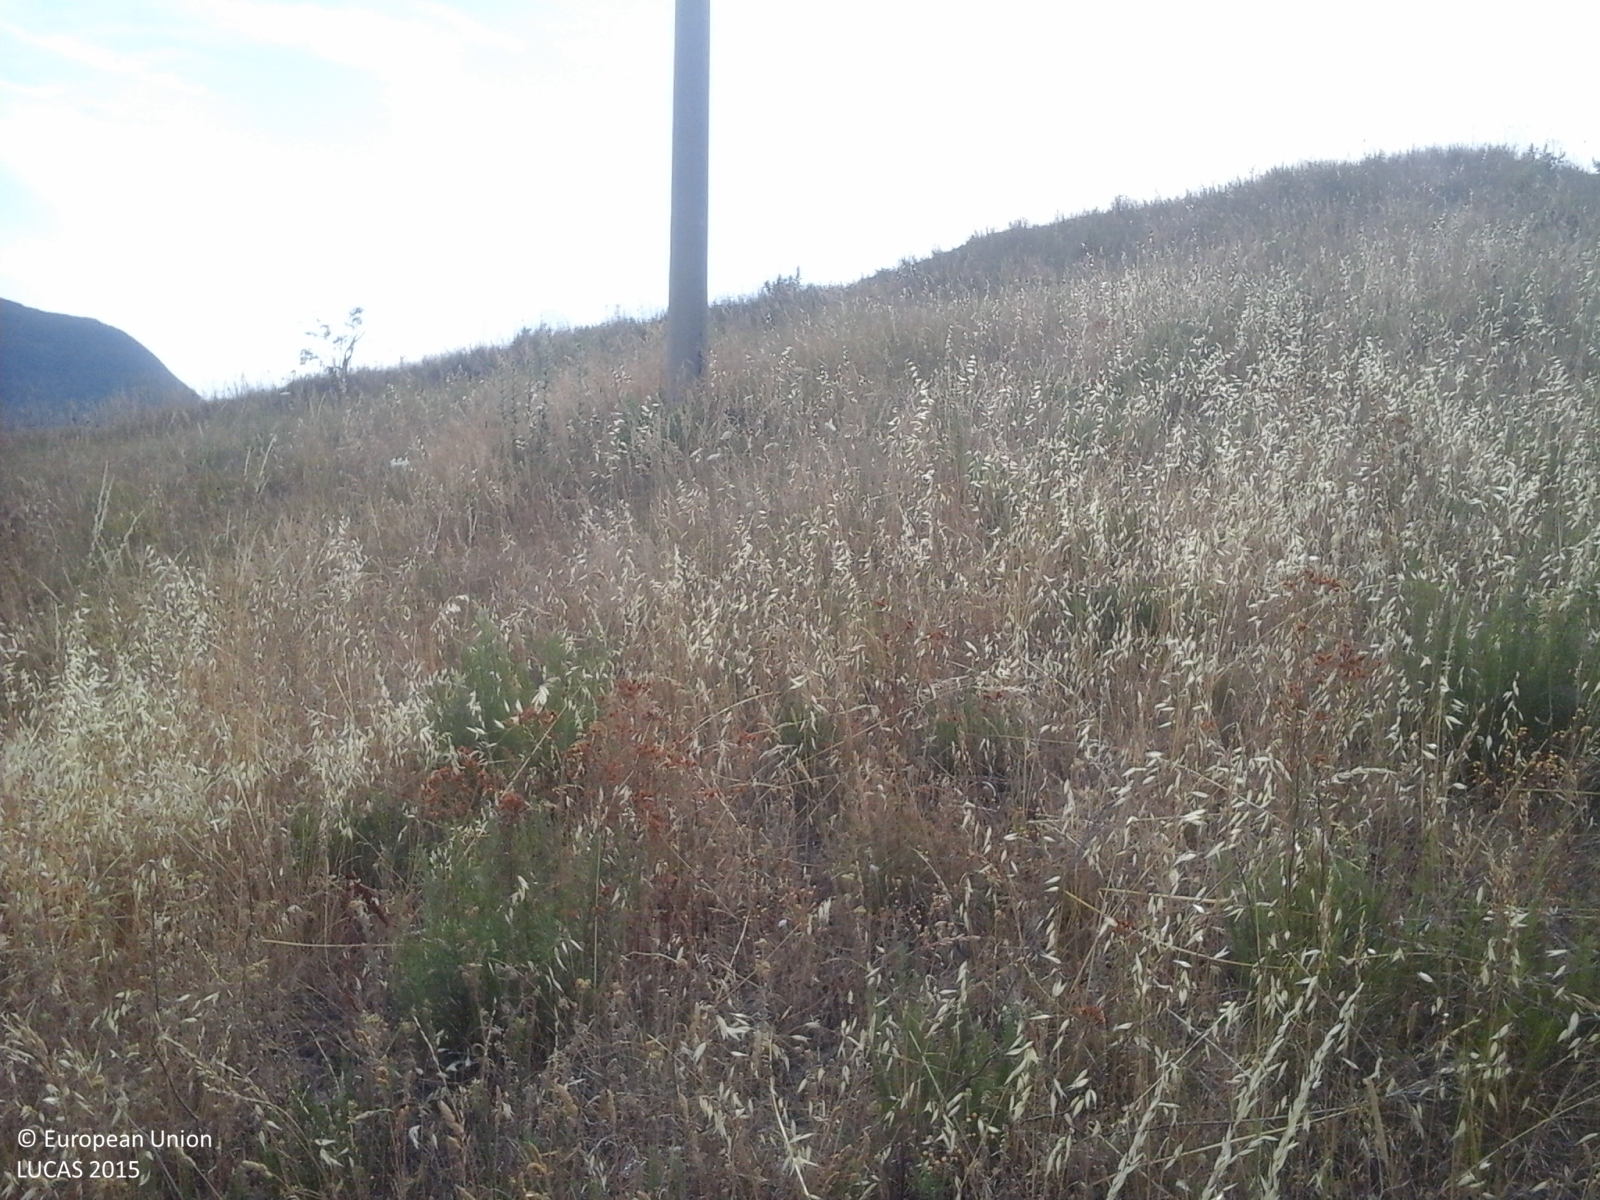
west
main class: Grassland
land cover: Grassland with sparse tree/shrub cover
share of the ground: > 75 %
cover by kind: herbaceous plants 90 %, broadleaved forest trees 5 %, shrubs 5 %
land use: Agriculture (excluding fallow land and kitchen gardens)
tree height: < 5 m
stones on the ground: 10 - 25 %
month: July
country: IT
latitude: 44.4403
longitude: 10.2883
